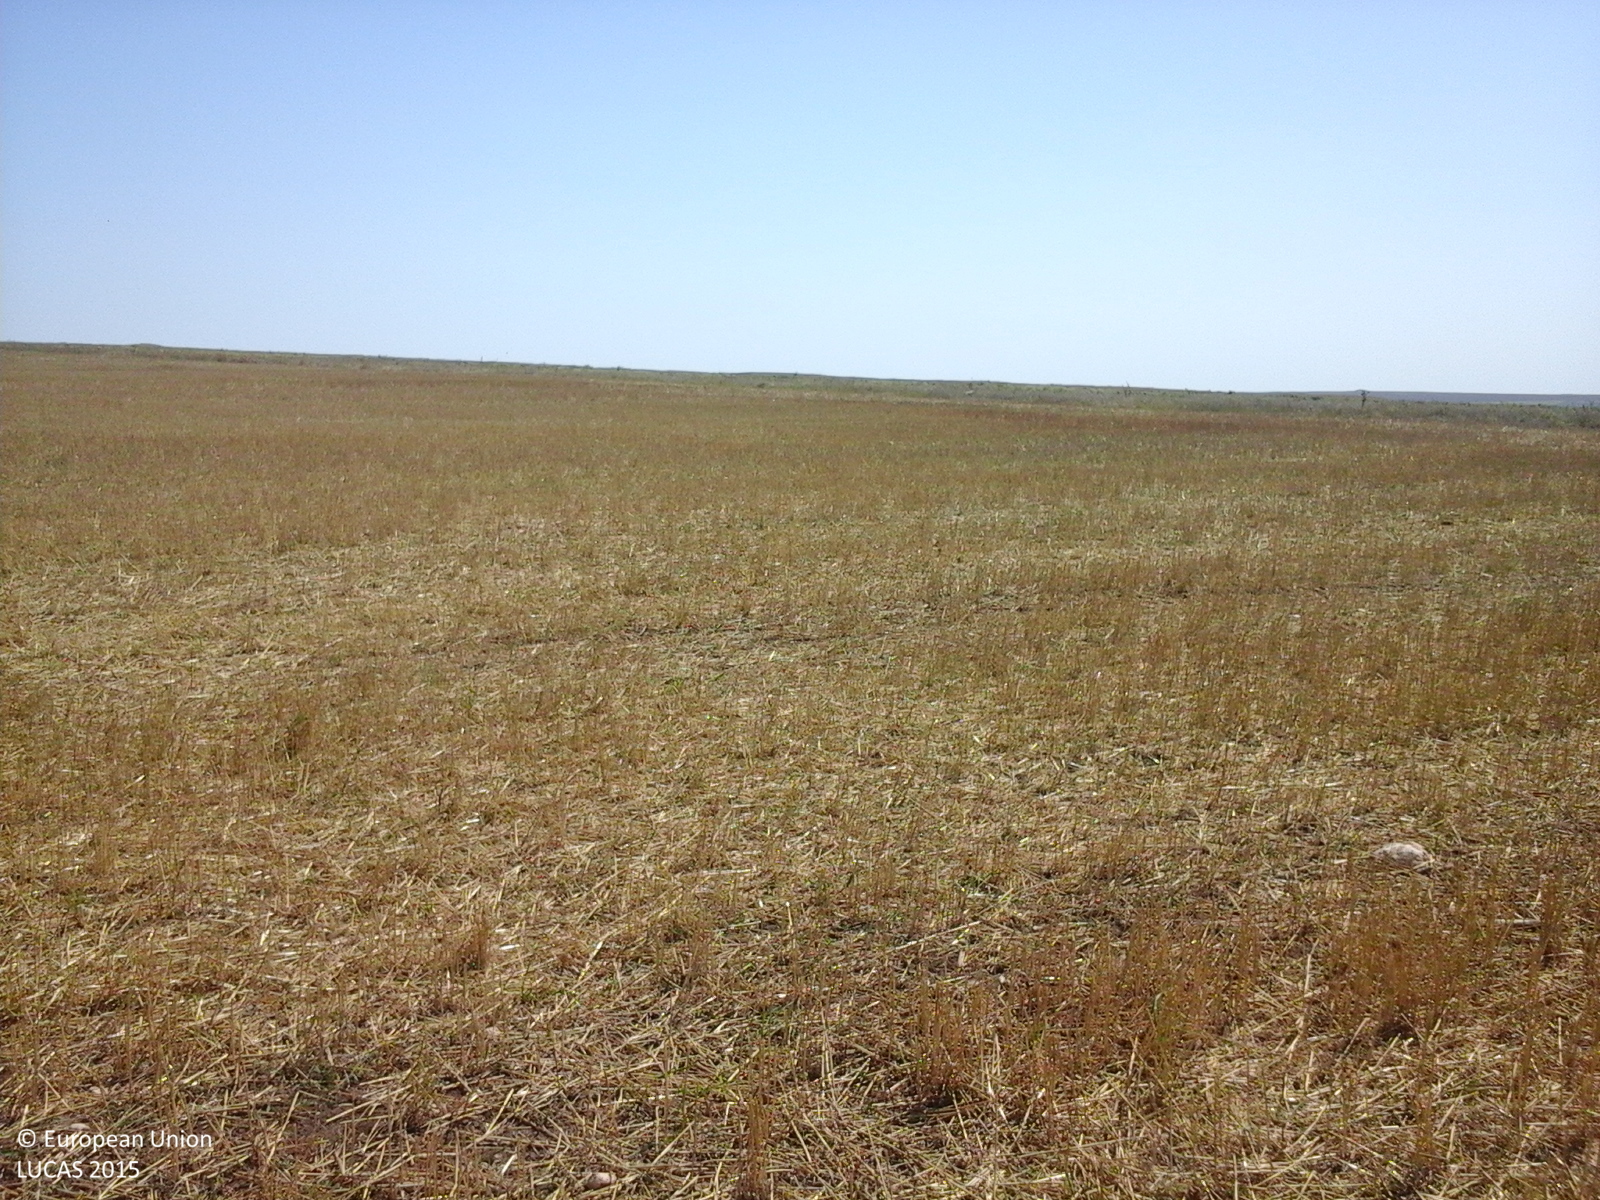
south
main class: Cropland
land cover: Common wheat
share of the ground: 10 - 25 %
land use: Agriculture (excluding fallow land and kitchen gardens)
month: August
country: RO
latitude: 44.4456
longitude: 28.4801
